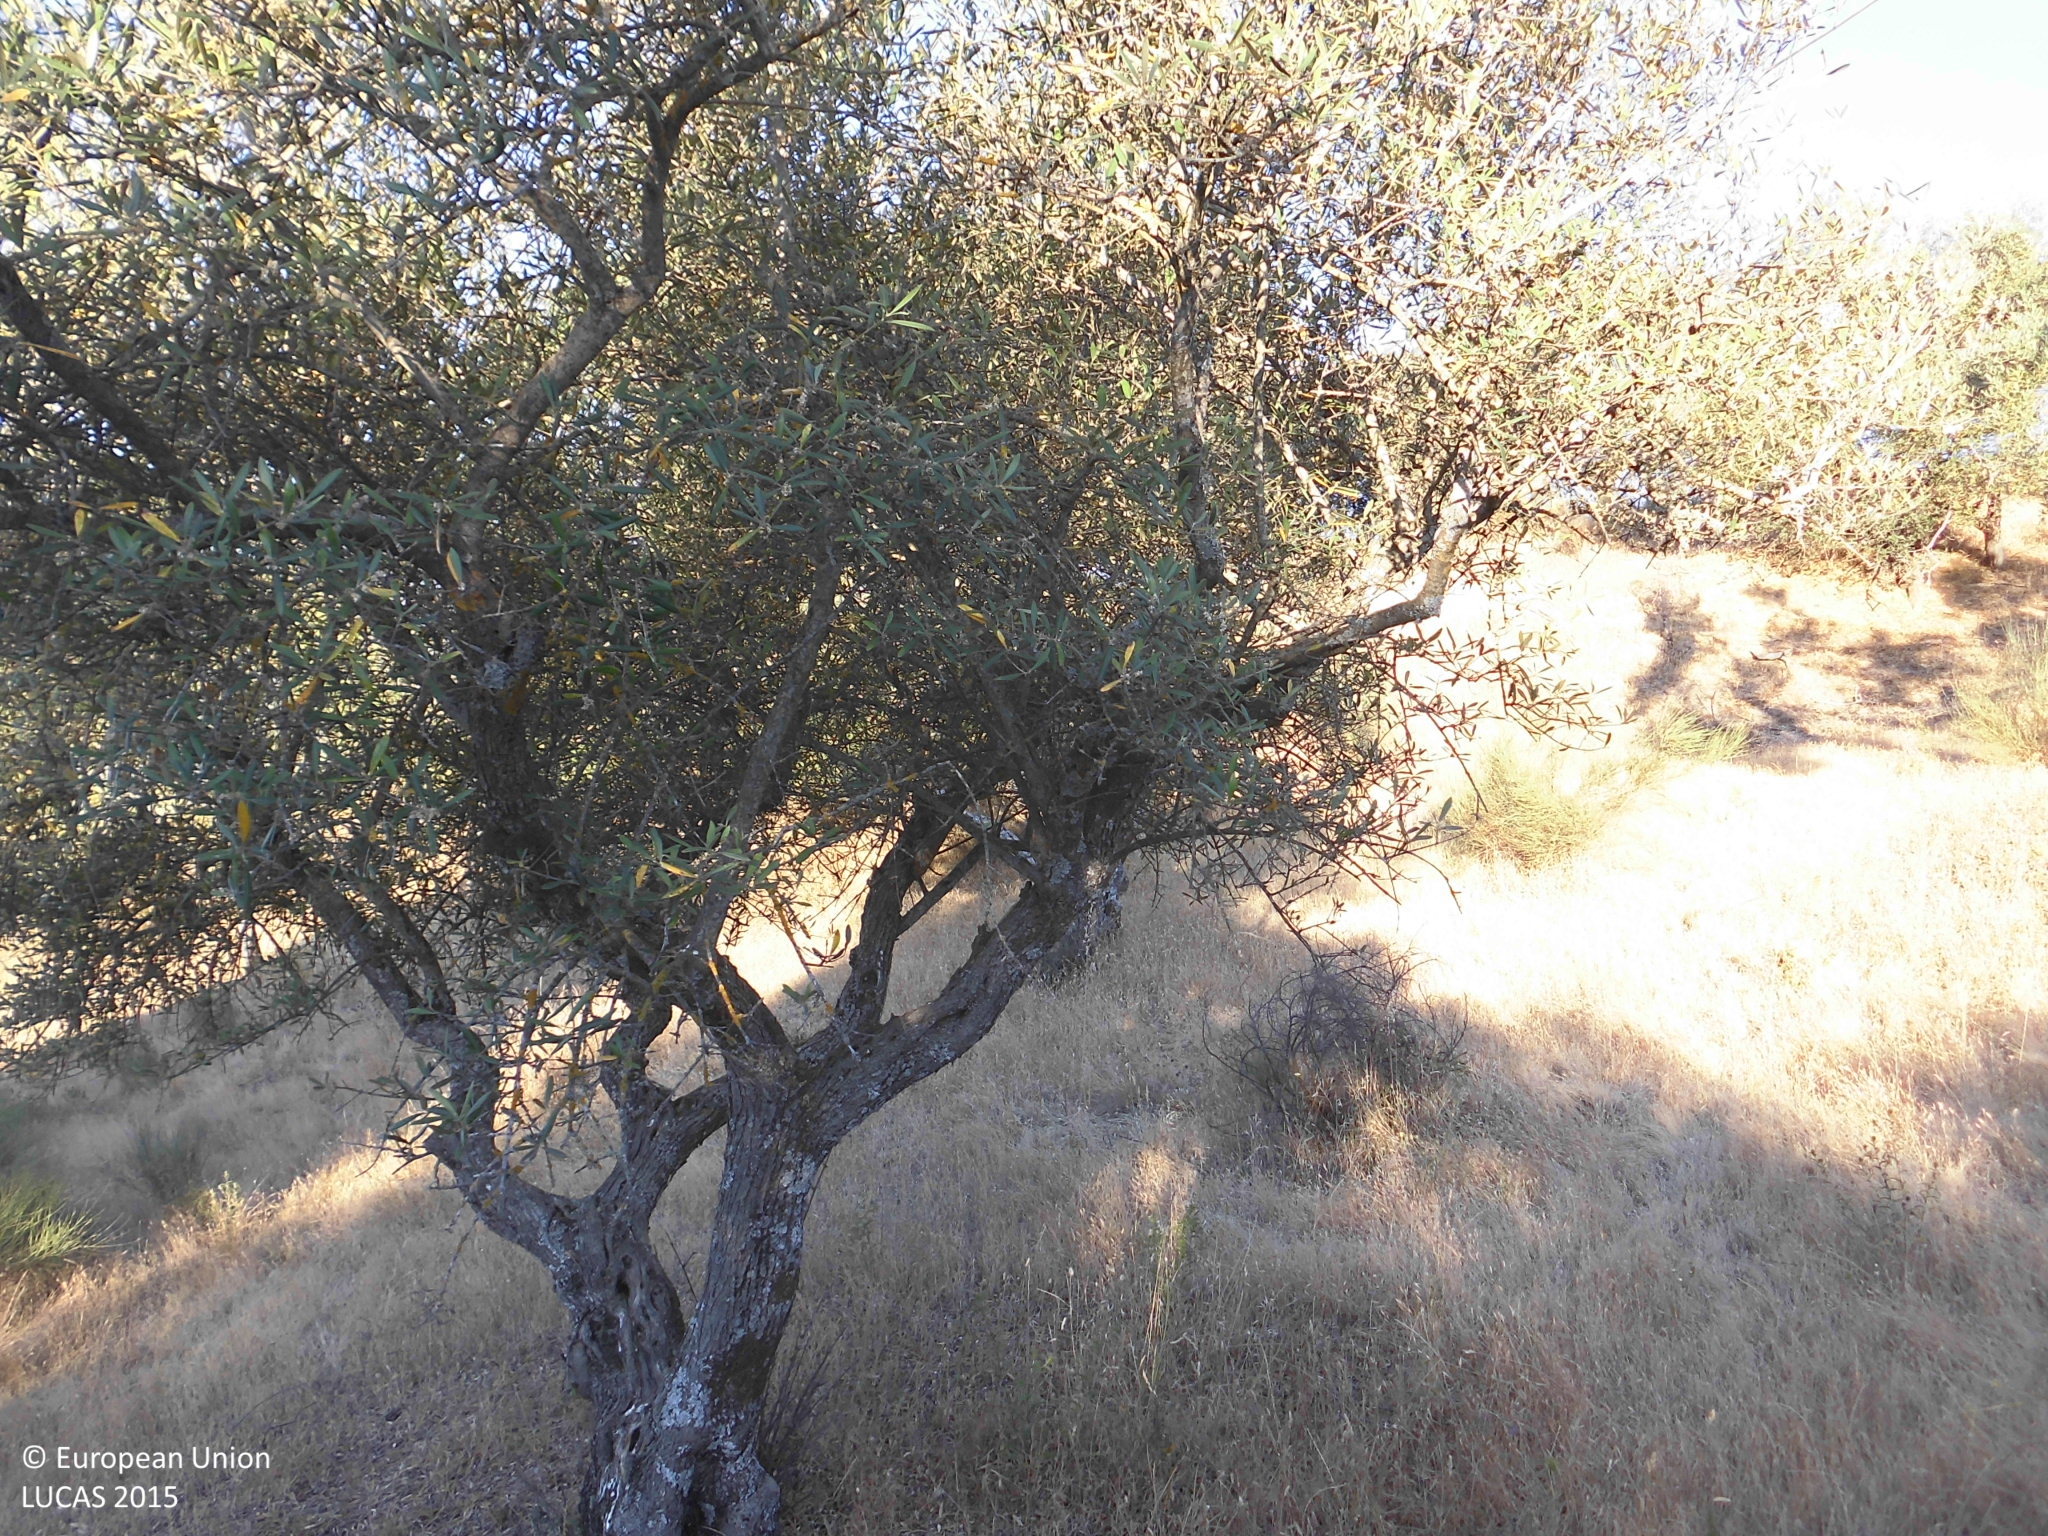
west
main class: Cropland
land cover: Olive groves
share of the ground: 10 - 25 %
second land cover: Spontaneously vegetated surfaces
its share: 50 - 75 %
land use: Agriculture (excluding fallow land and kitchen gardens)
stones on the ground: 10 - 25 %
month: May
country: ES
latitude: 39.7875
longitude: -6.6728
